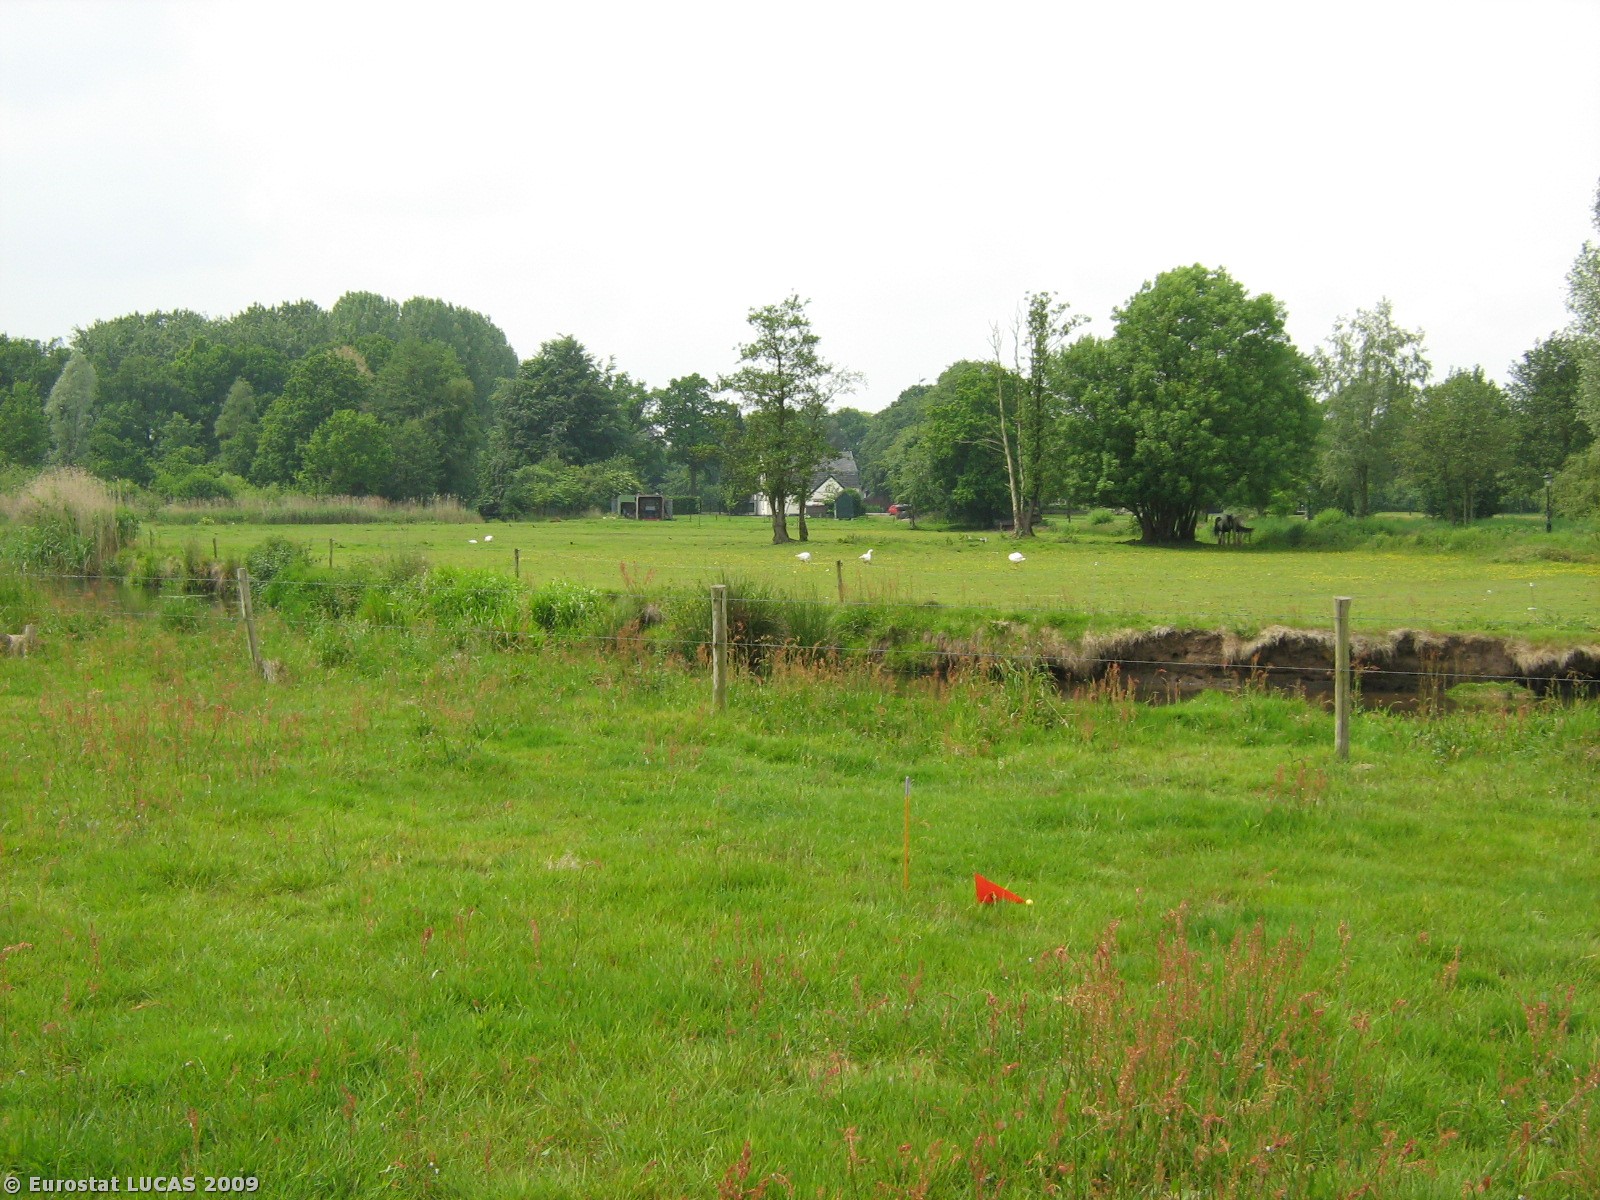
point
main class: Grassland
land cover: Grassland without tree/shrub cover
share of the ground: > 75 %
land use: Nature reserves
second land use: Agriculture (excluding fallow land and kitchen gardens)
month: May
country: NL
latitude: 51.3001
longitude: 5.4514
